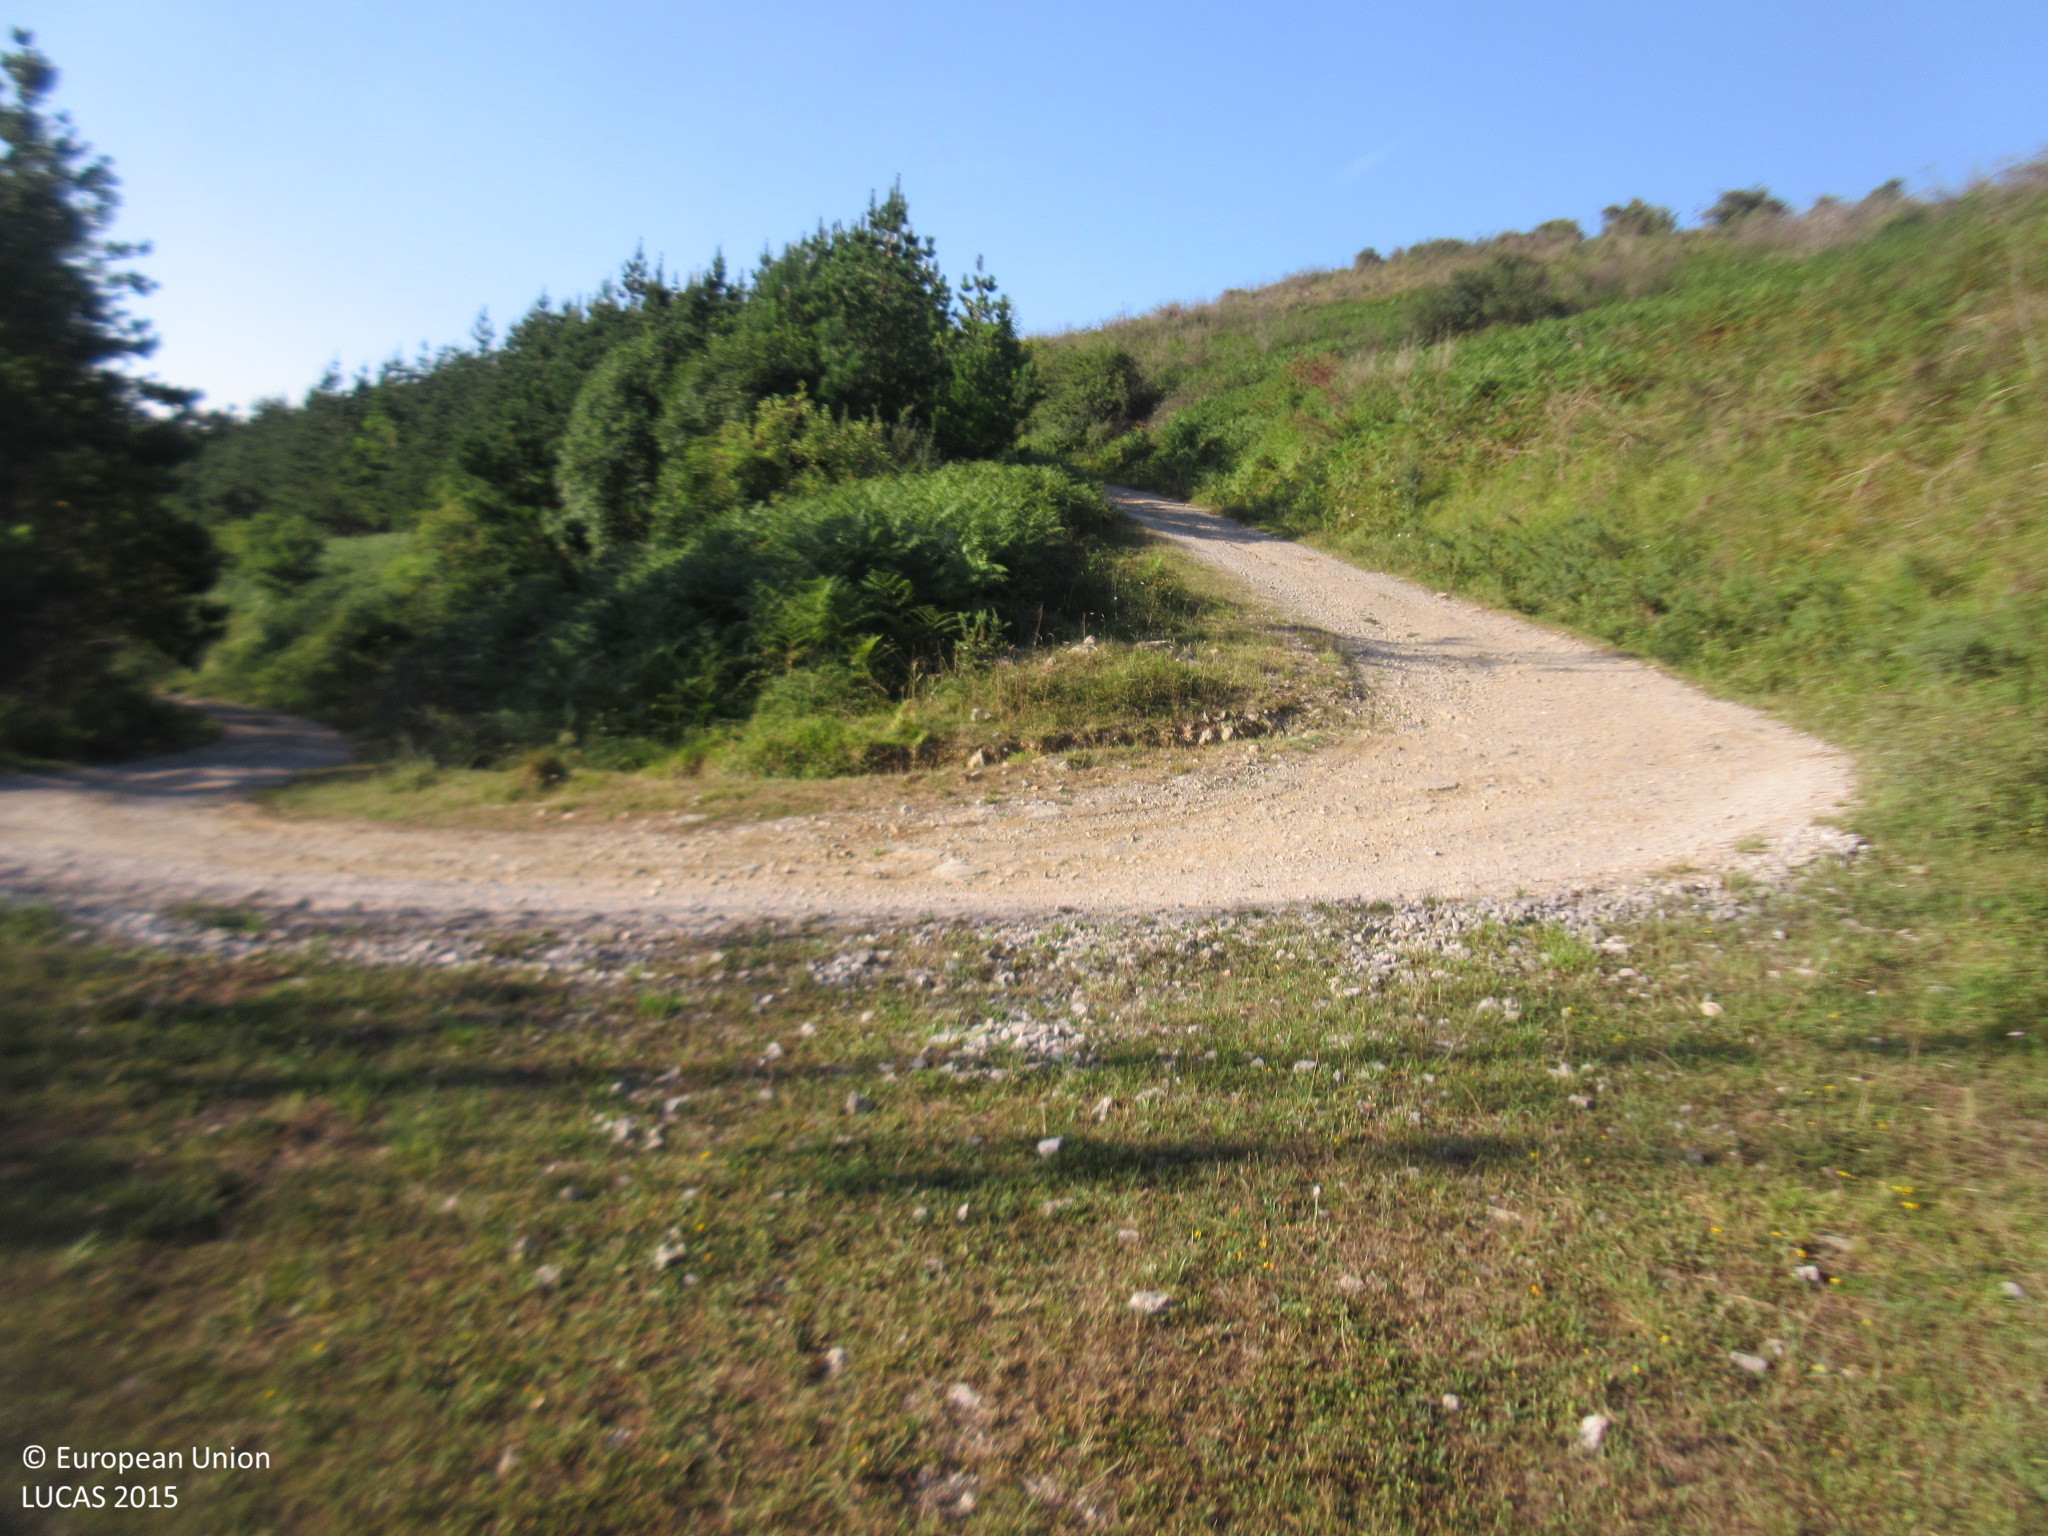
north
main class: Woodland
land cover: Pine dominated coniferous woodland
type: hemiboreal forest and nemoral coniferous forest and mixed broadleaved-coniferous forest
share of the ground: > 75 %
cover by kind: coniferous forest trees 95 %, shrubs 5 %
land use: Forestry
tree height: > 5 m
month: July
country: ES
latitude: 43.2237
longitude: -3.9238
